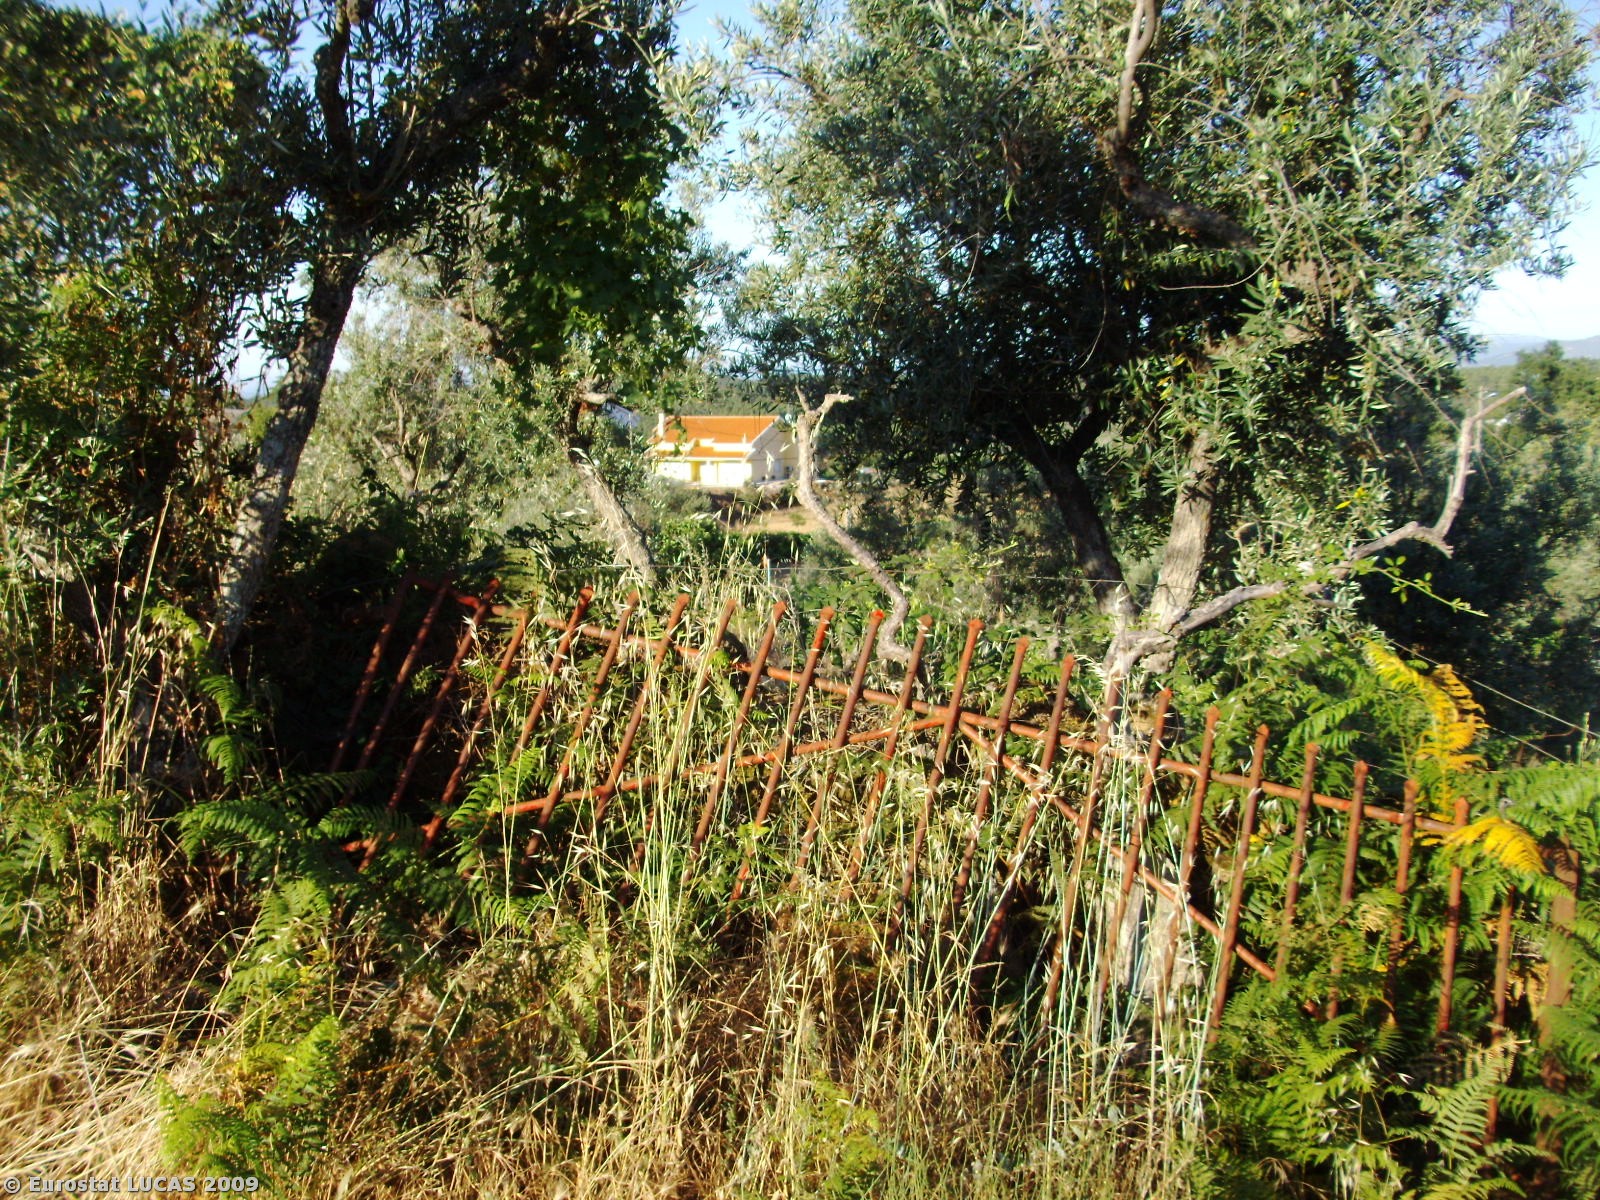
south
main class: Cropland
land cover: Olive groves
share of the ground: 50 - 75 %
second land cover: Vineyards
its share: 10 - 25 %
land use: Agriculture (excluding fallow land and kitchen gardens)
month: June
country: PT
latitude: 40.0366
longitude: -7.5547
